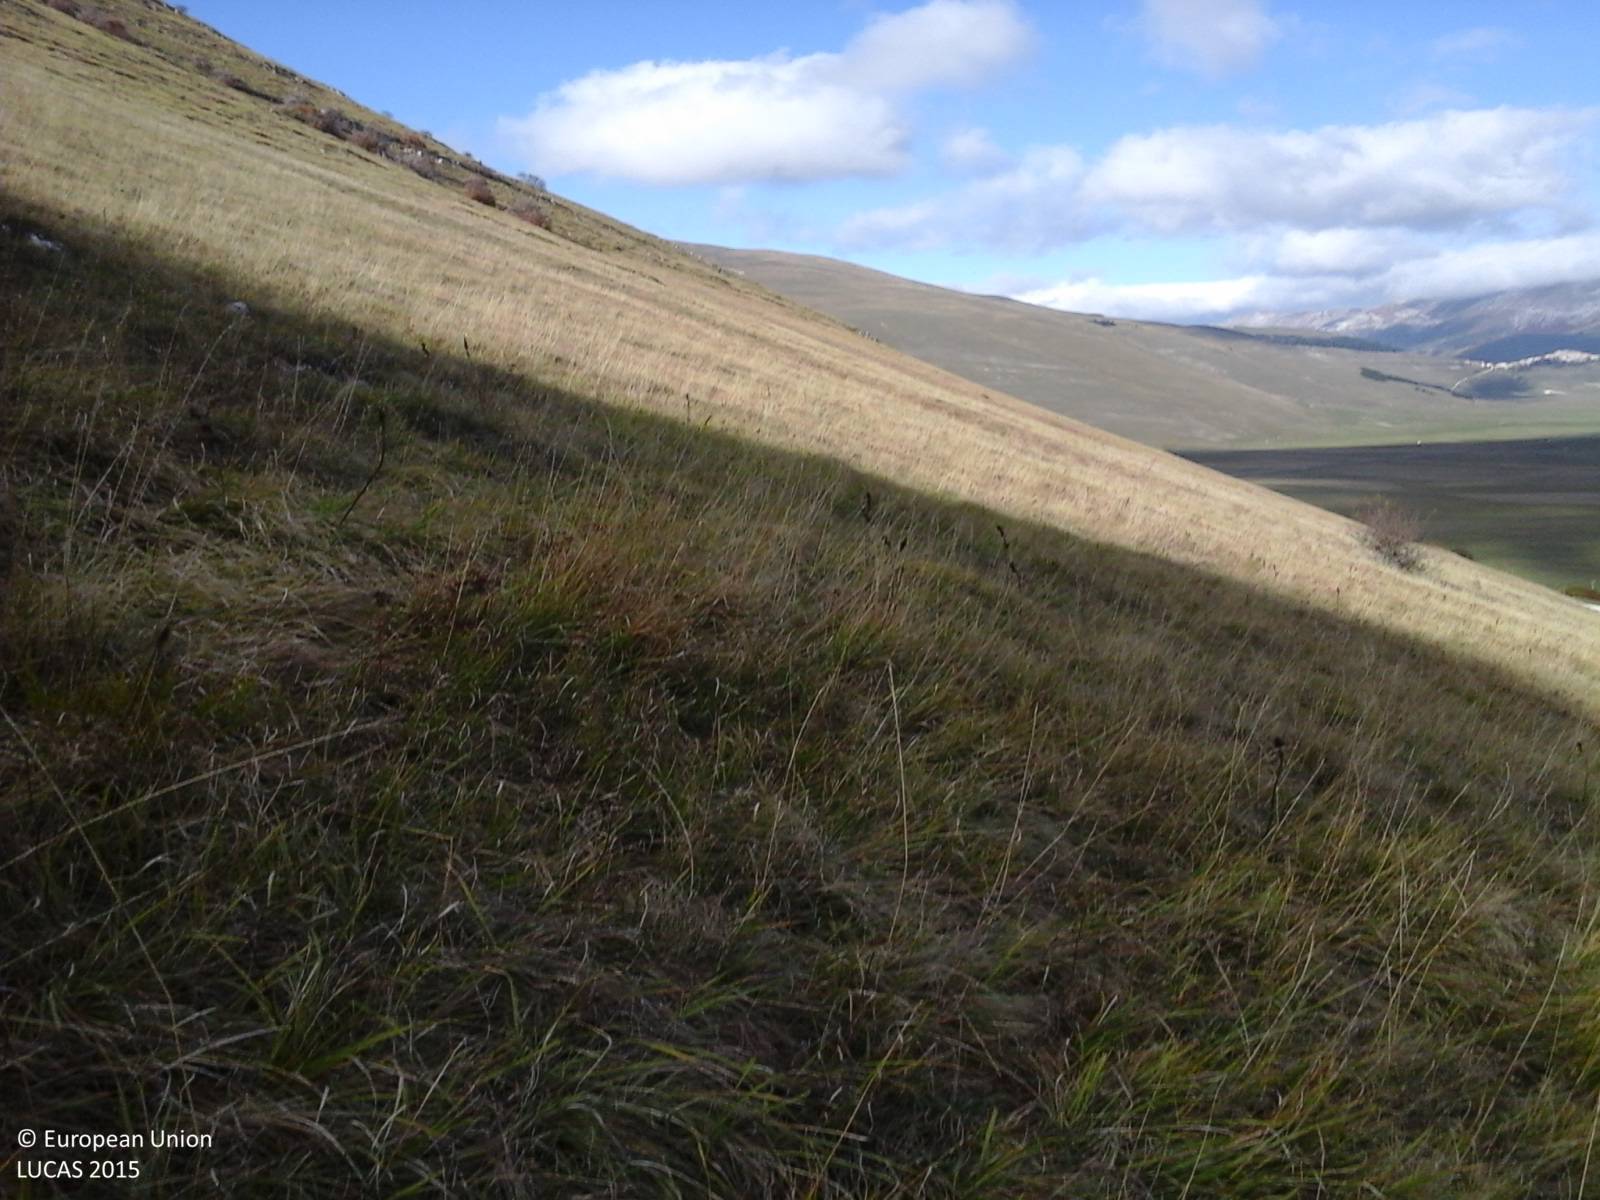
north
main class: Grassland
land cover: Grassland without tree/shrub cover
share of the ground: > 75 %
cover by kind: herbaceous plants 100 %
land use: Agriculture (excluding fallow land and kitchen gardens)
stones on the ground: < 10 %
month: October
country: IT
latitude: 42.7848
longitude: 13.1811
